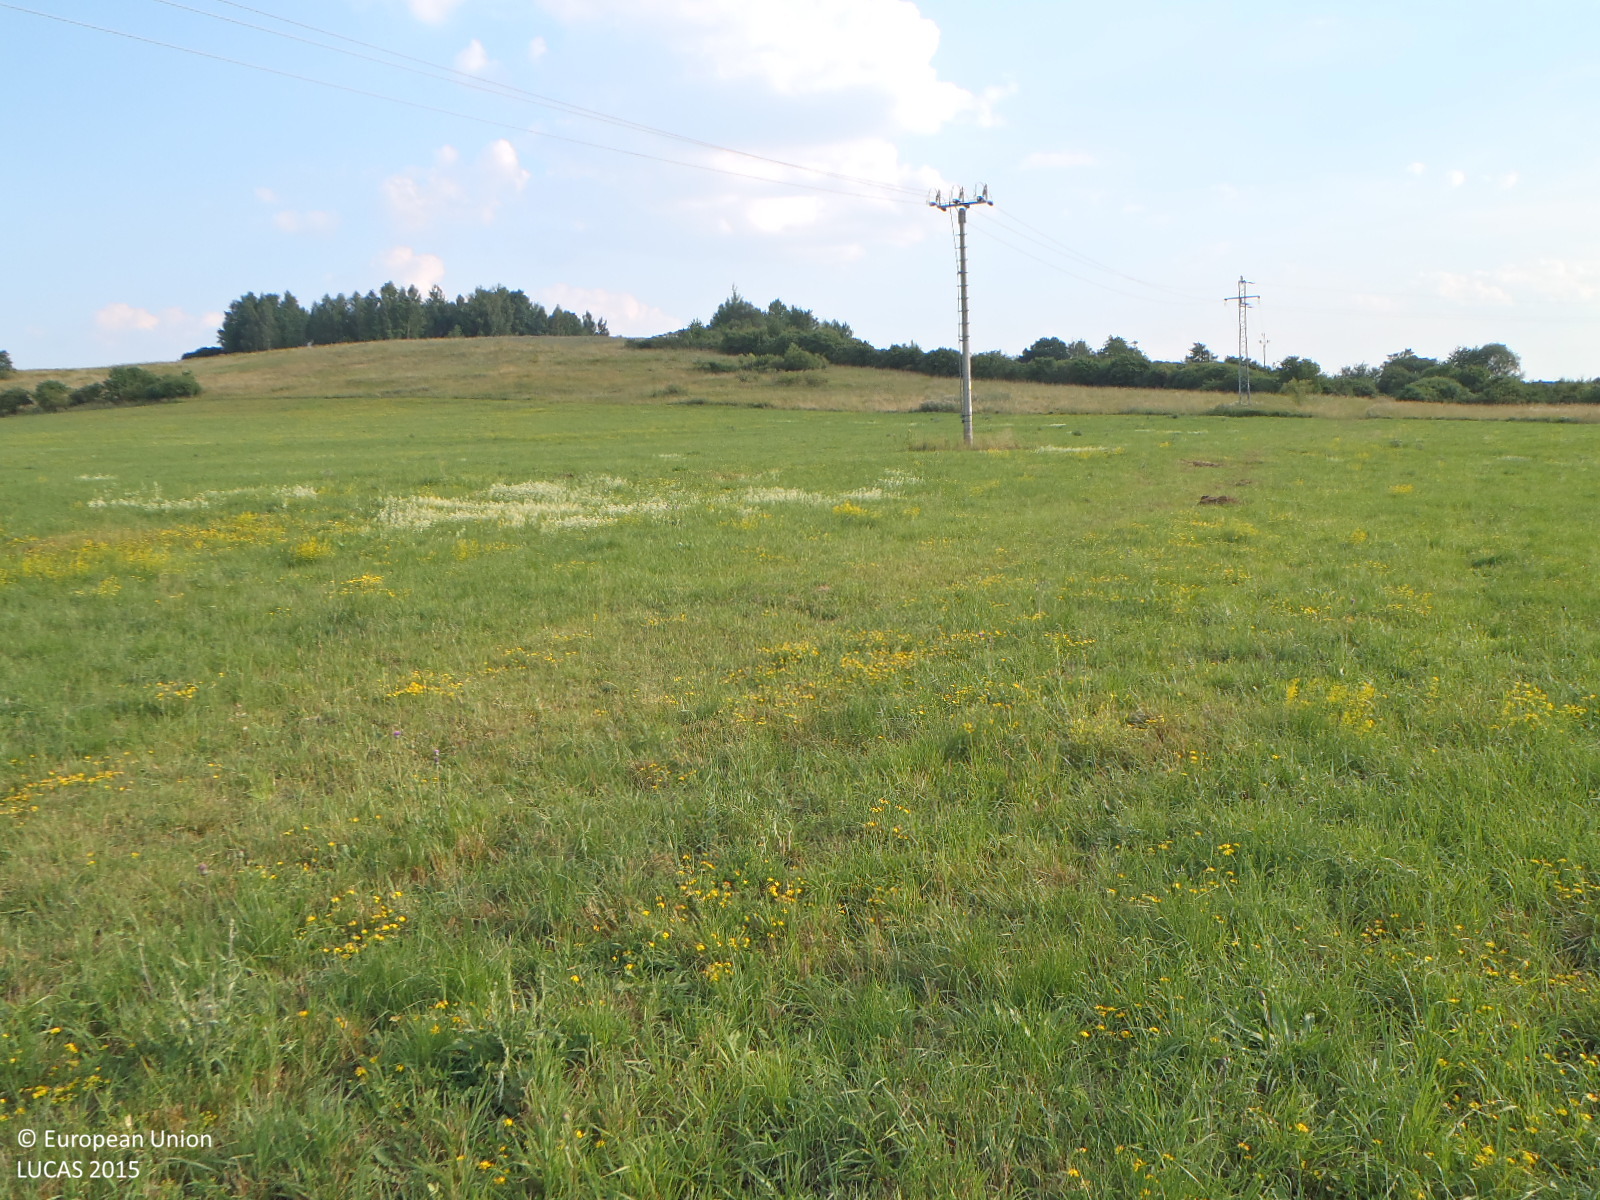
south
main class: Grassland
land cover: Grassland without tree/shrub cover
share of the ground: > 75 %
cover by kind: herbaceous plants 100 %
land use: Agriculture (excluding fallow land and kitchen gardens)
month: August
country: CZ
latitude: 50.6868
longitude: 14.5738
